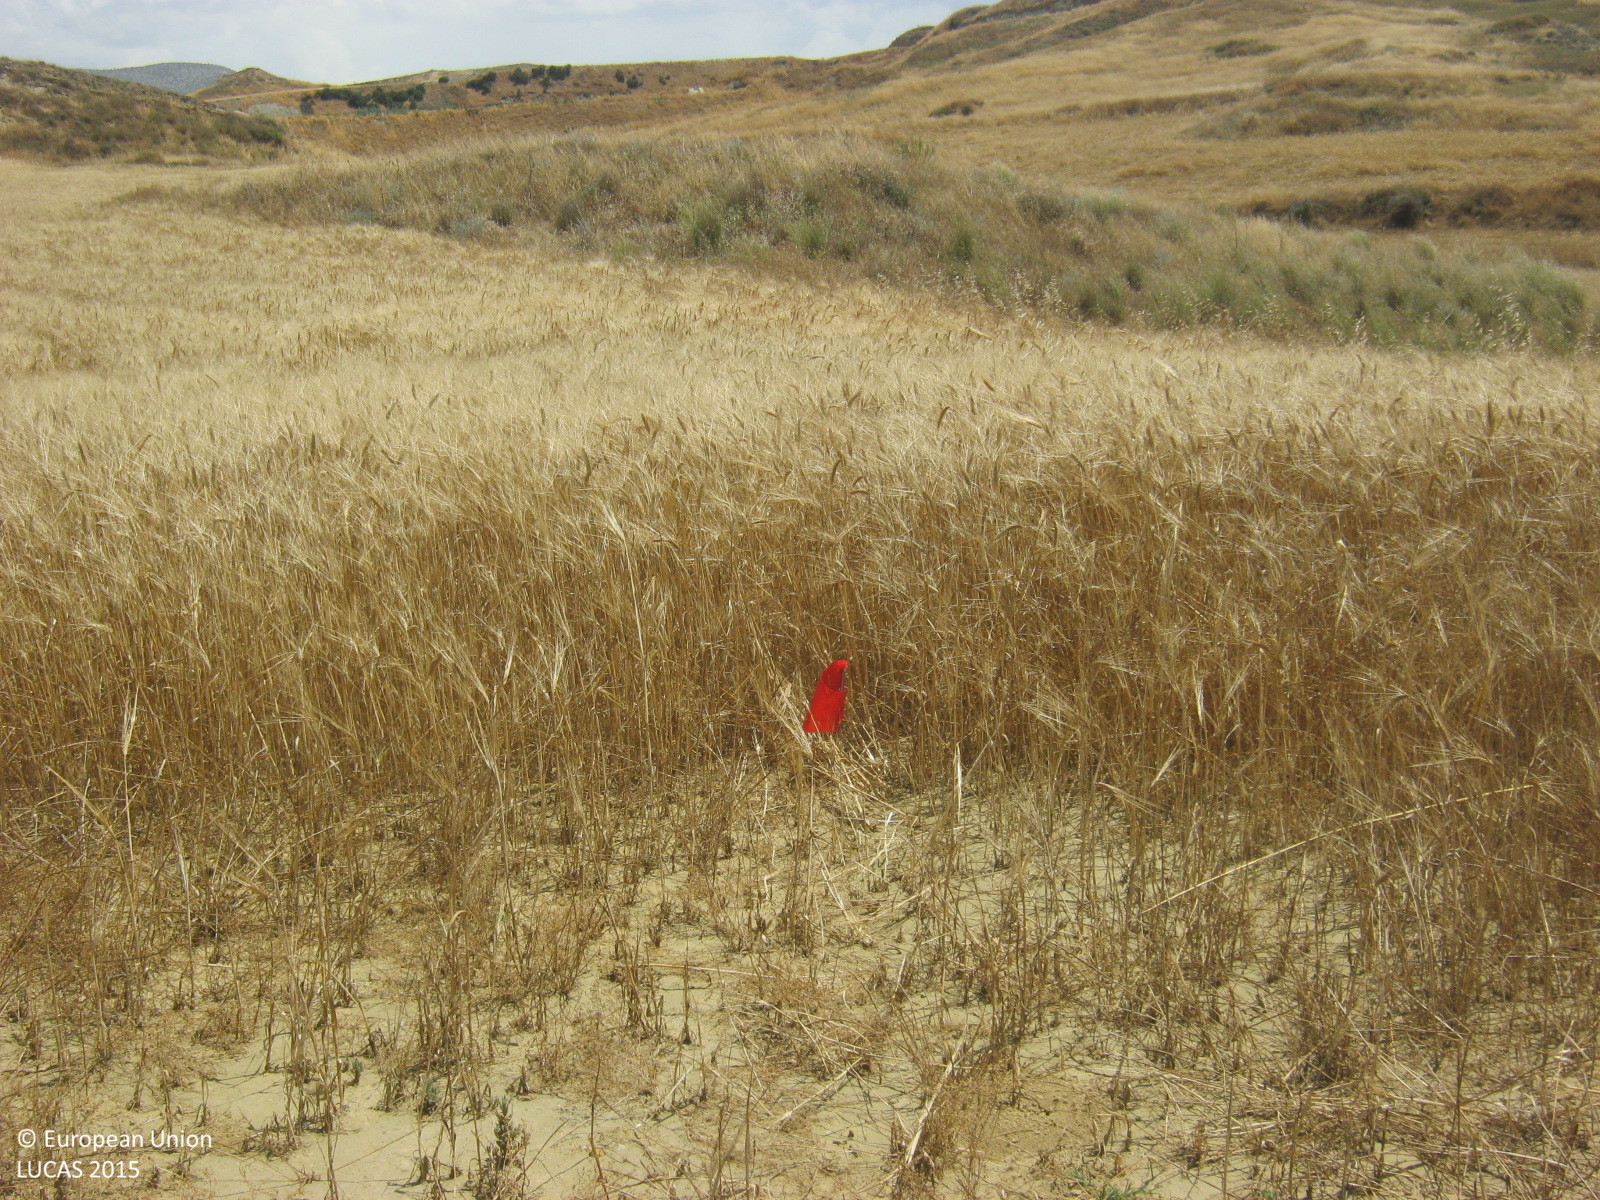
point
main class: Cropland
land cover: Common wheat
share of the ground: > 75 %
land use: Agriculture (excluding fallow land and kitchen gardens)
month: May
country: CY
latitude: 35.0834
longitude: 33.1150
